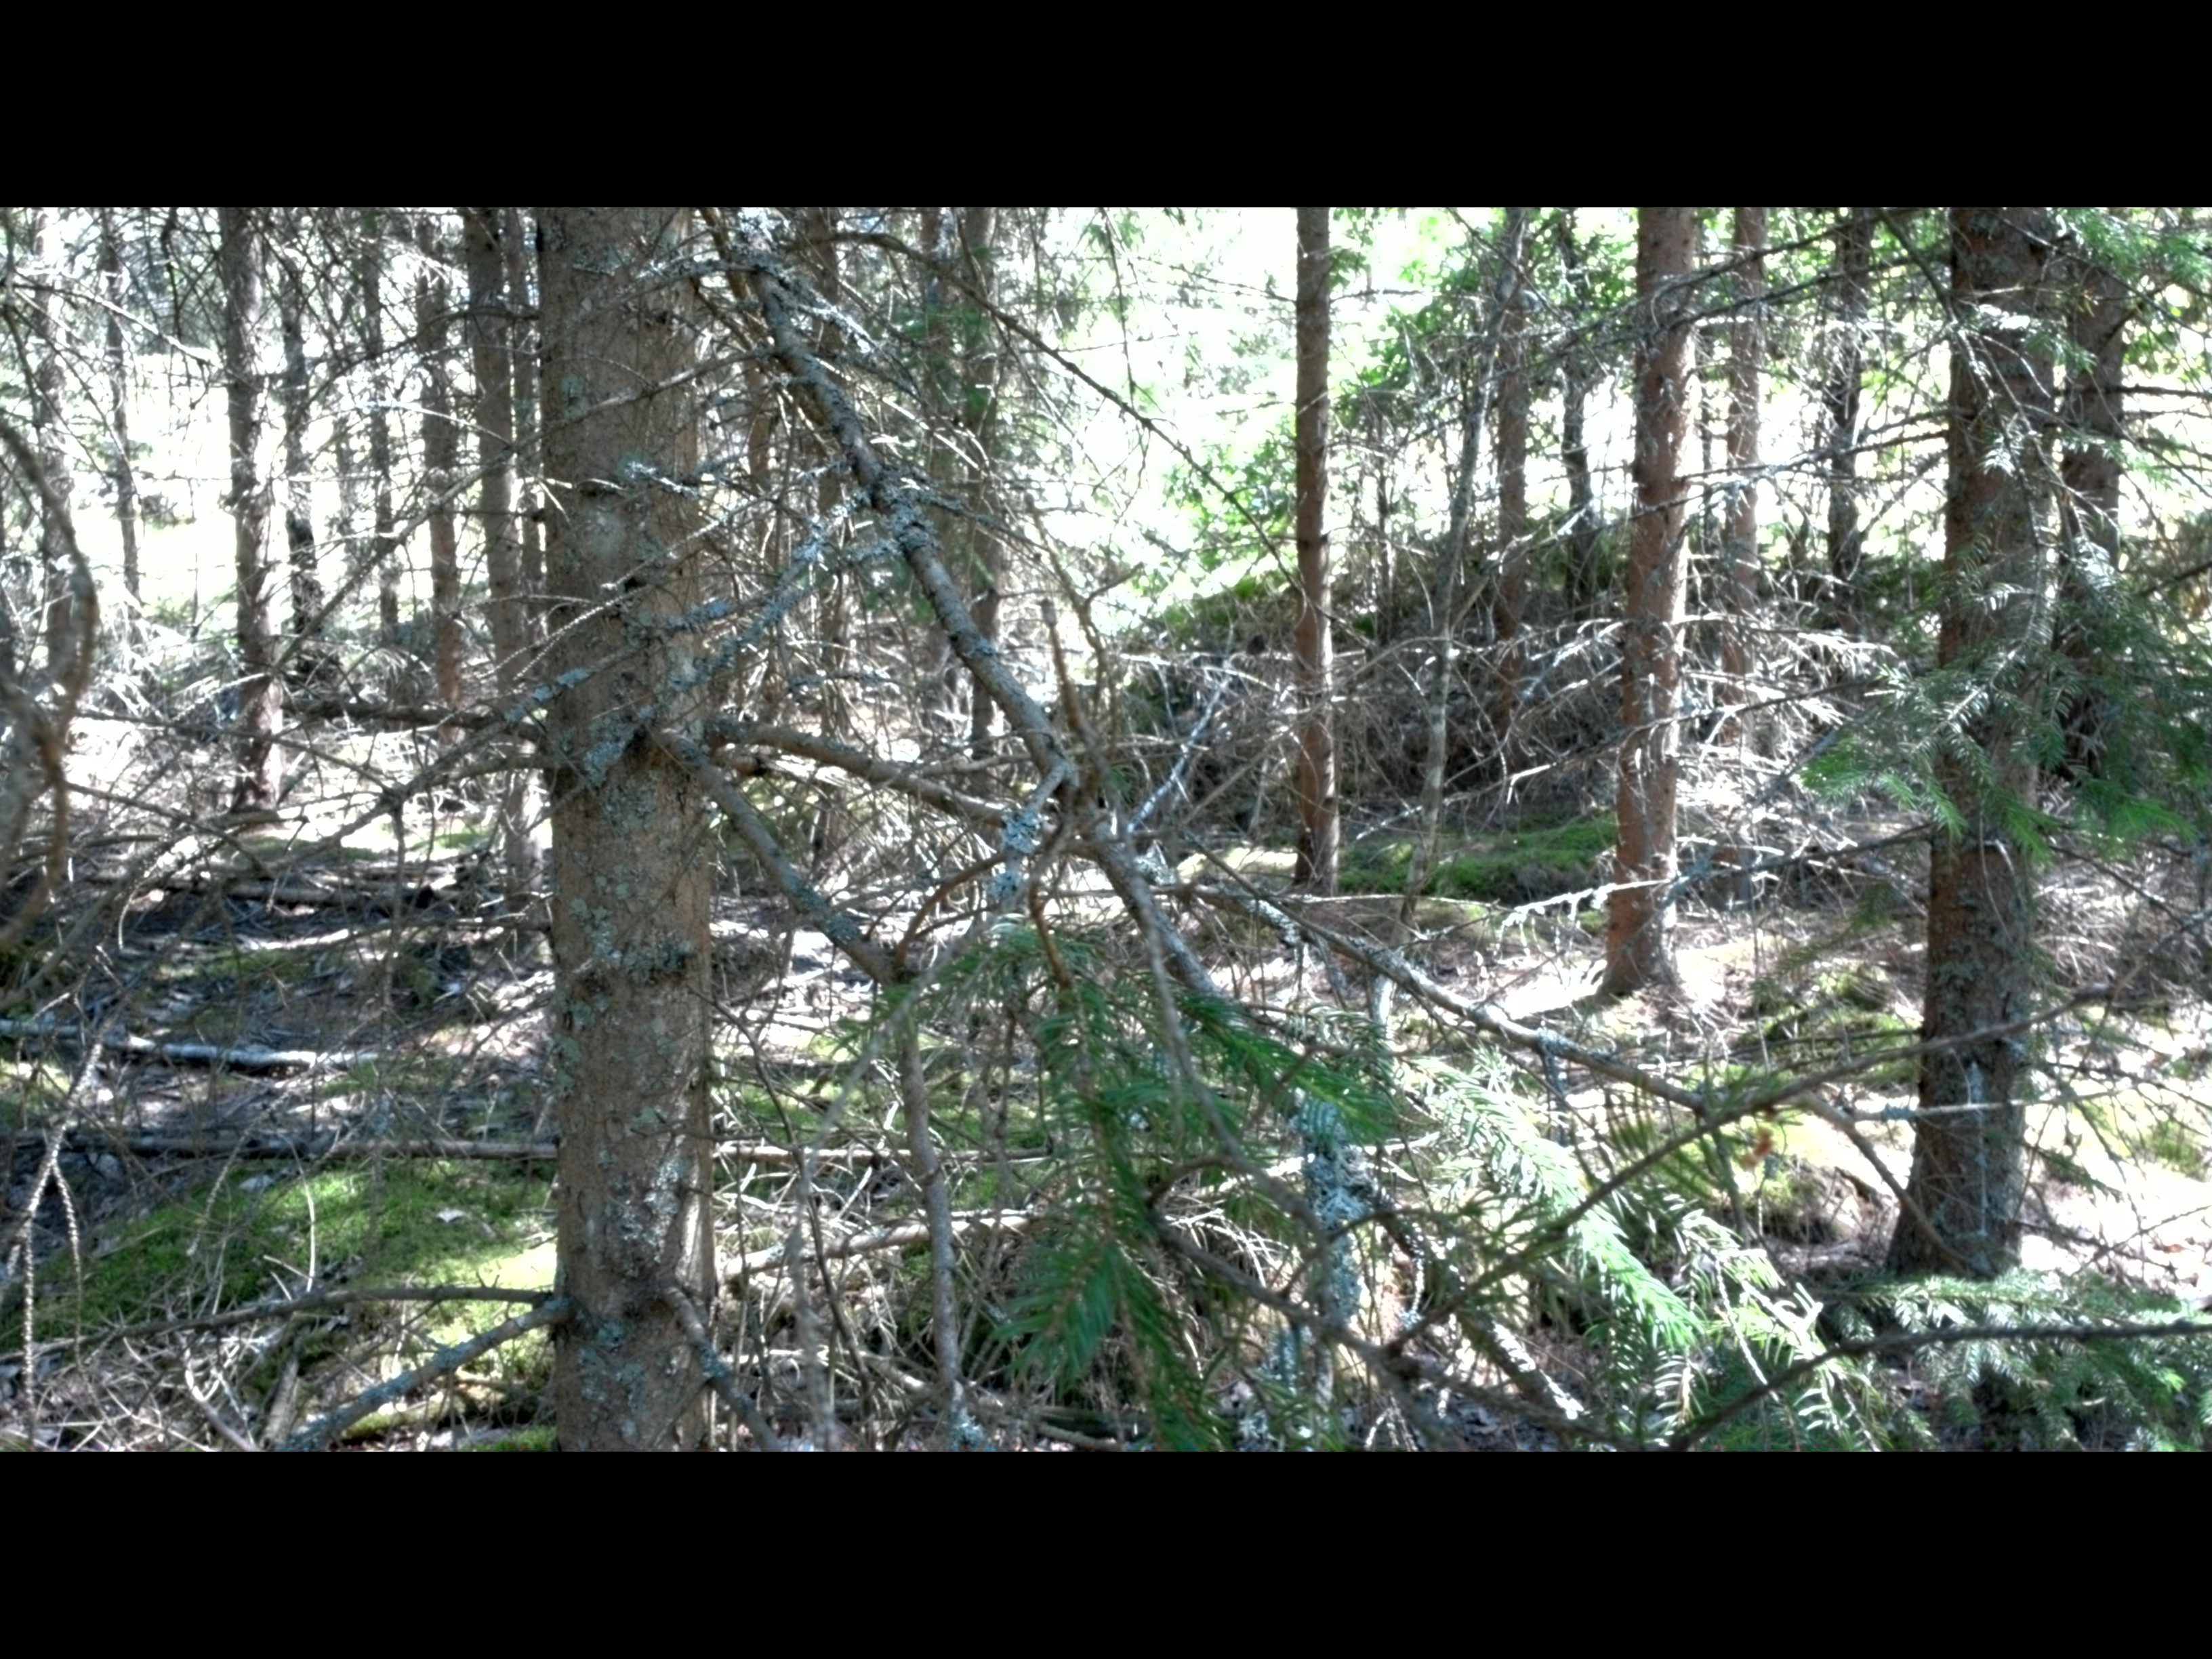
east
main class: Woodland
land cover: Spruce dominated coniferous woodland
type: boreal forest
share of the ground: > 75 %
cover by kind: coniferous forest trees 70 %, broadleaved forest trees 15 %, lichens and mosses 10 %, shrubs 5 %
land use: Forestry
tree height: > 5 m
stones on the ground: < 10 %
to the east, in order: Spruce dominated coniferous woodland; Grassland with sparse tree/shrub cover; Pine dominated coniferous woodland; Other coniferous woodland; Pine dominated coniferous woodland; Electric lines; Broadleaved woodland; Other mixed woodland
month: July
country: SE
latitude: 58.1831
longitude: 16.6129
